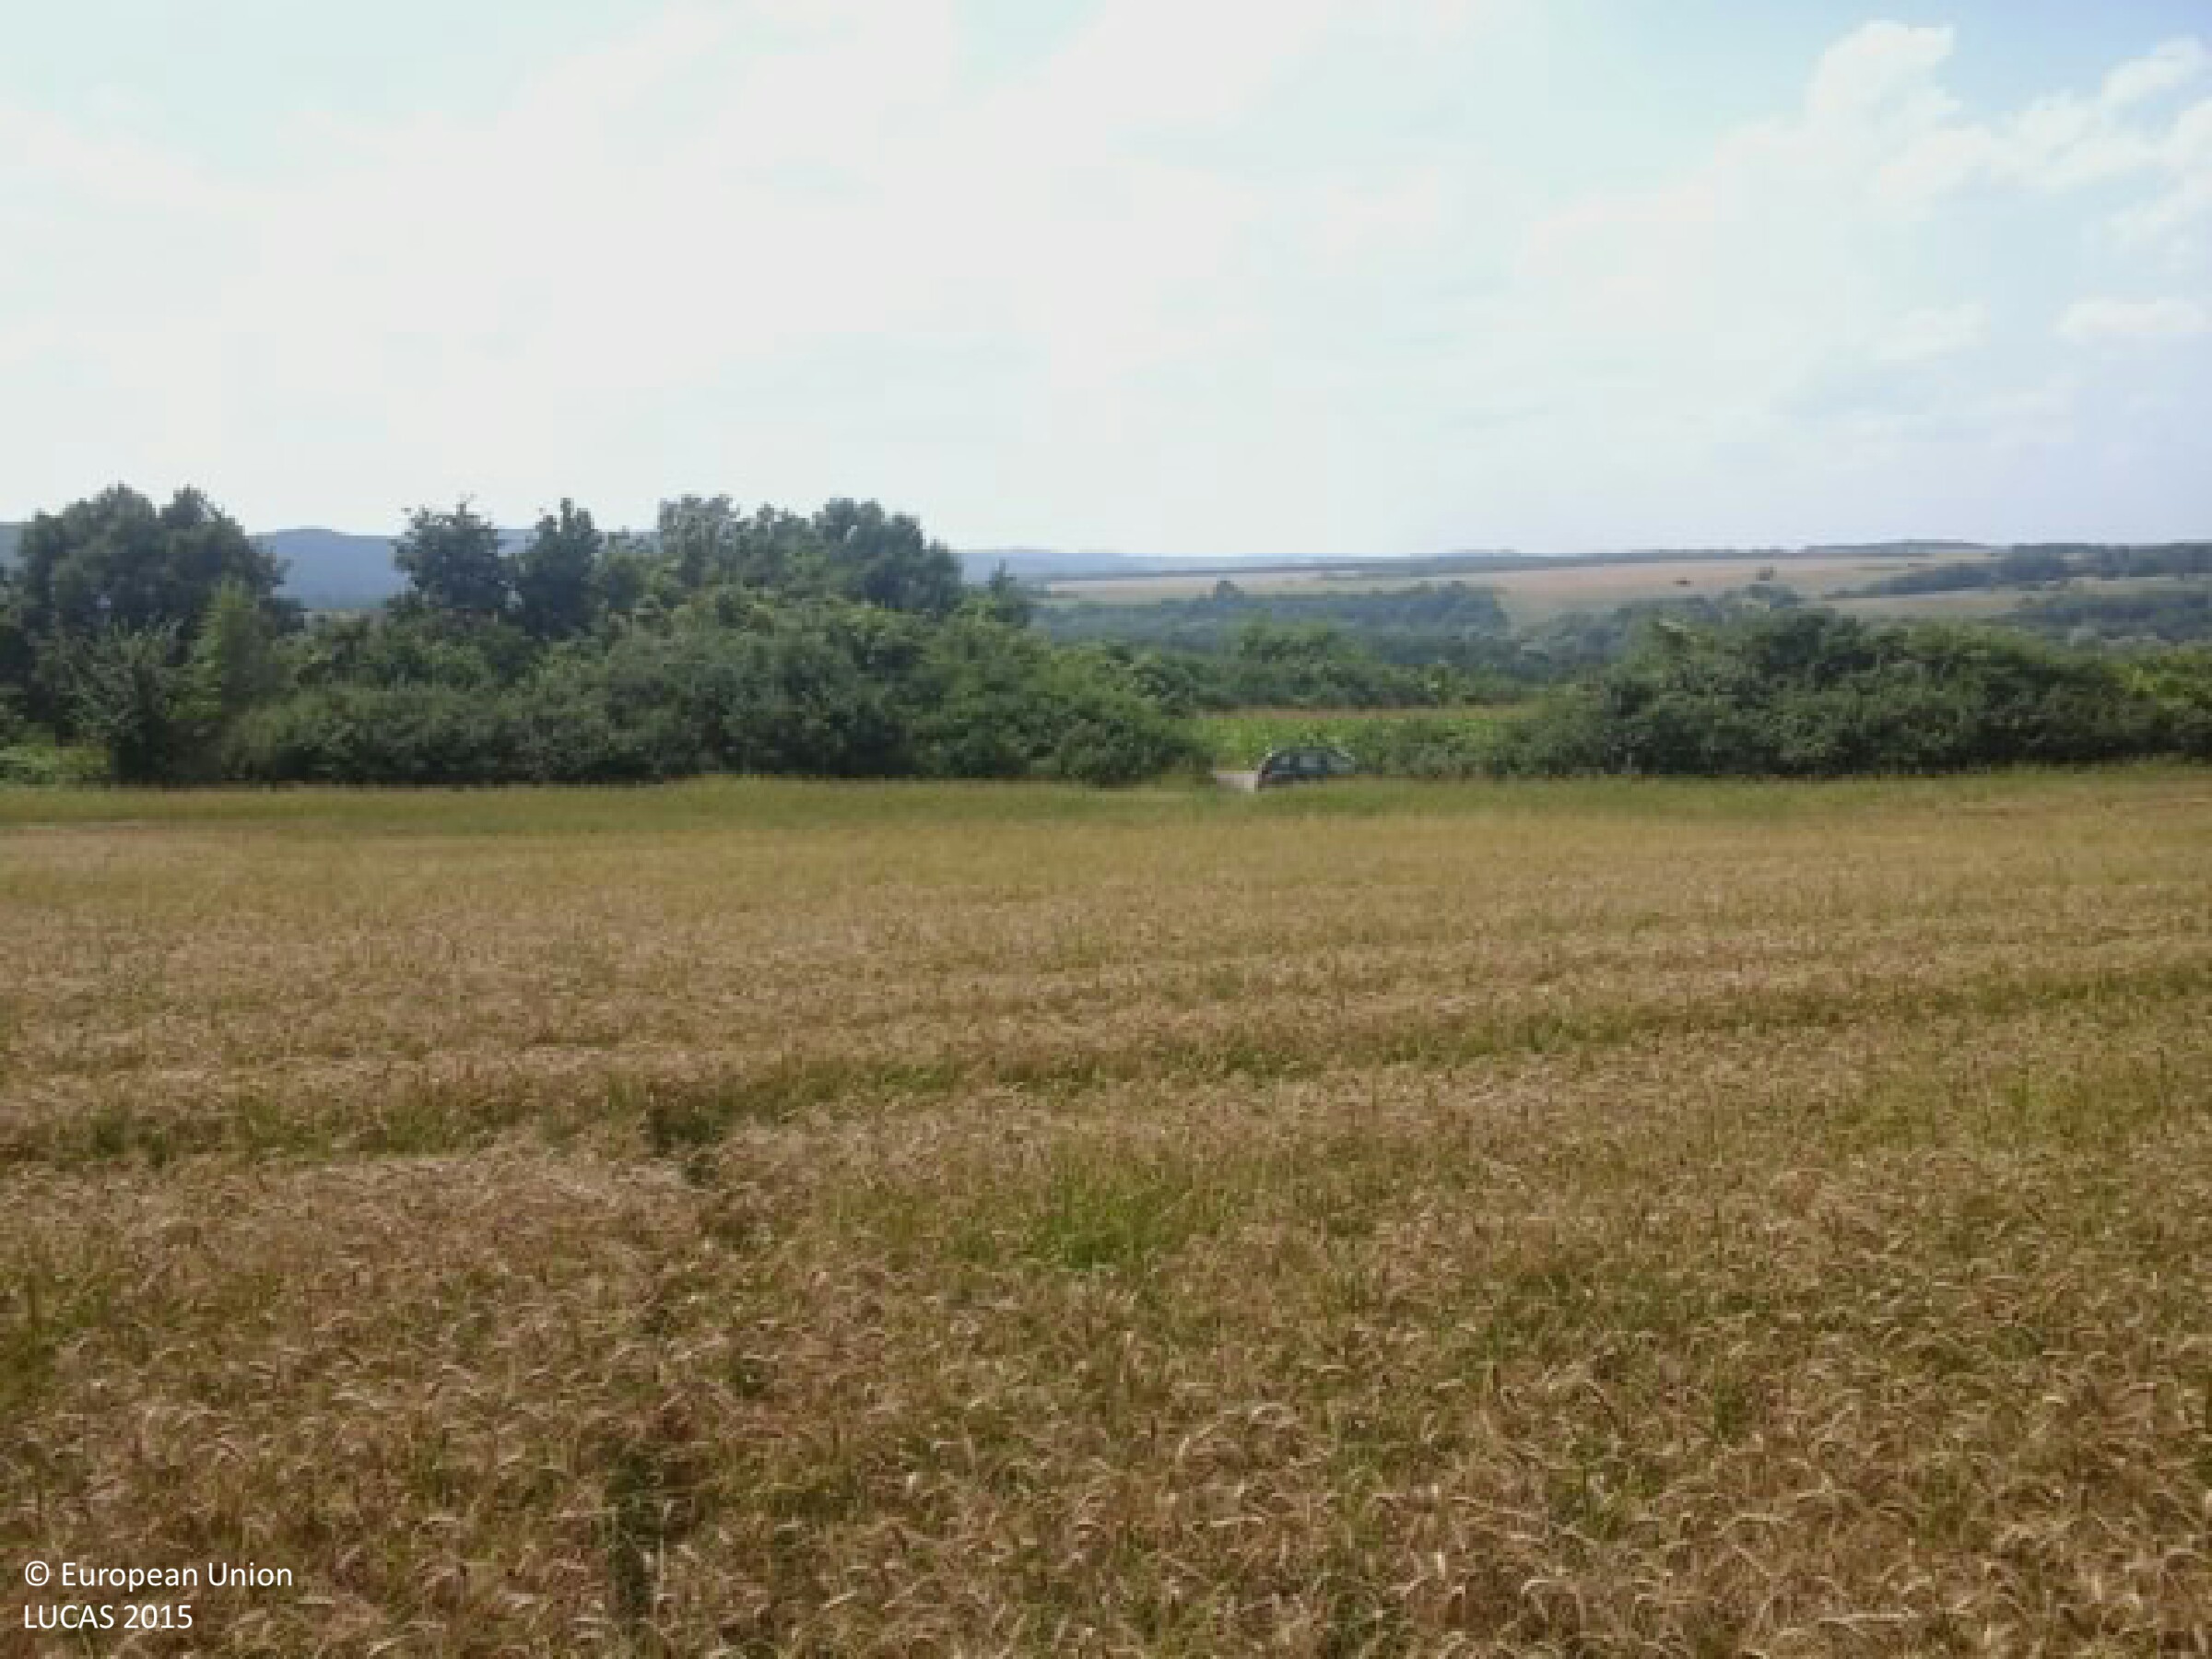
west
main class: Cropland
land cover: Triticale
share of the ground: > 75 %
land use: Agriculture (excluding fallow land and kitchen gardens)
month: August
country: HU
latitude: 46.2001
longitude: 18.1846
